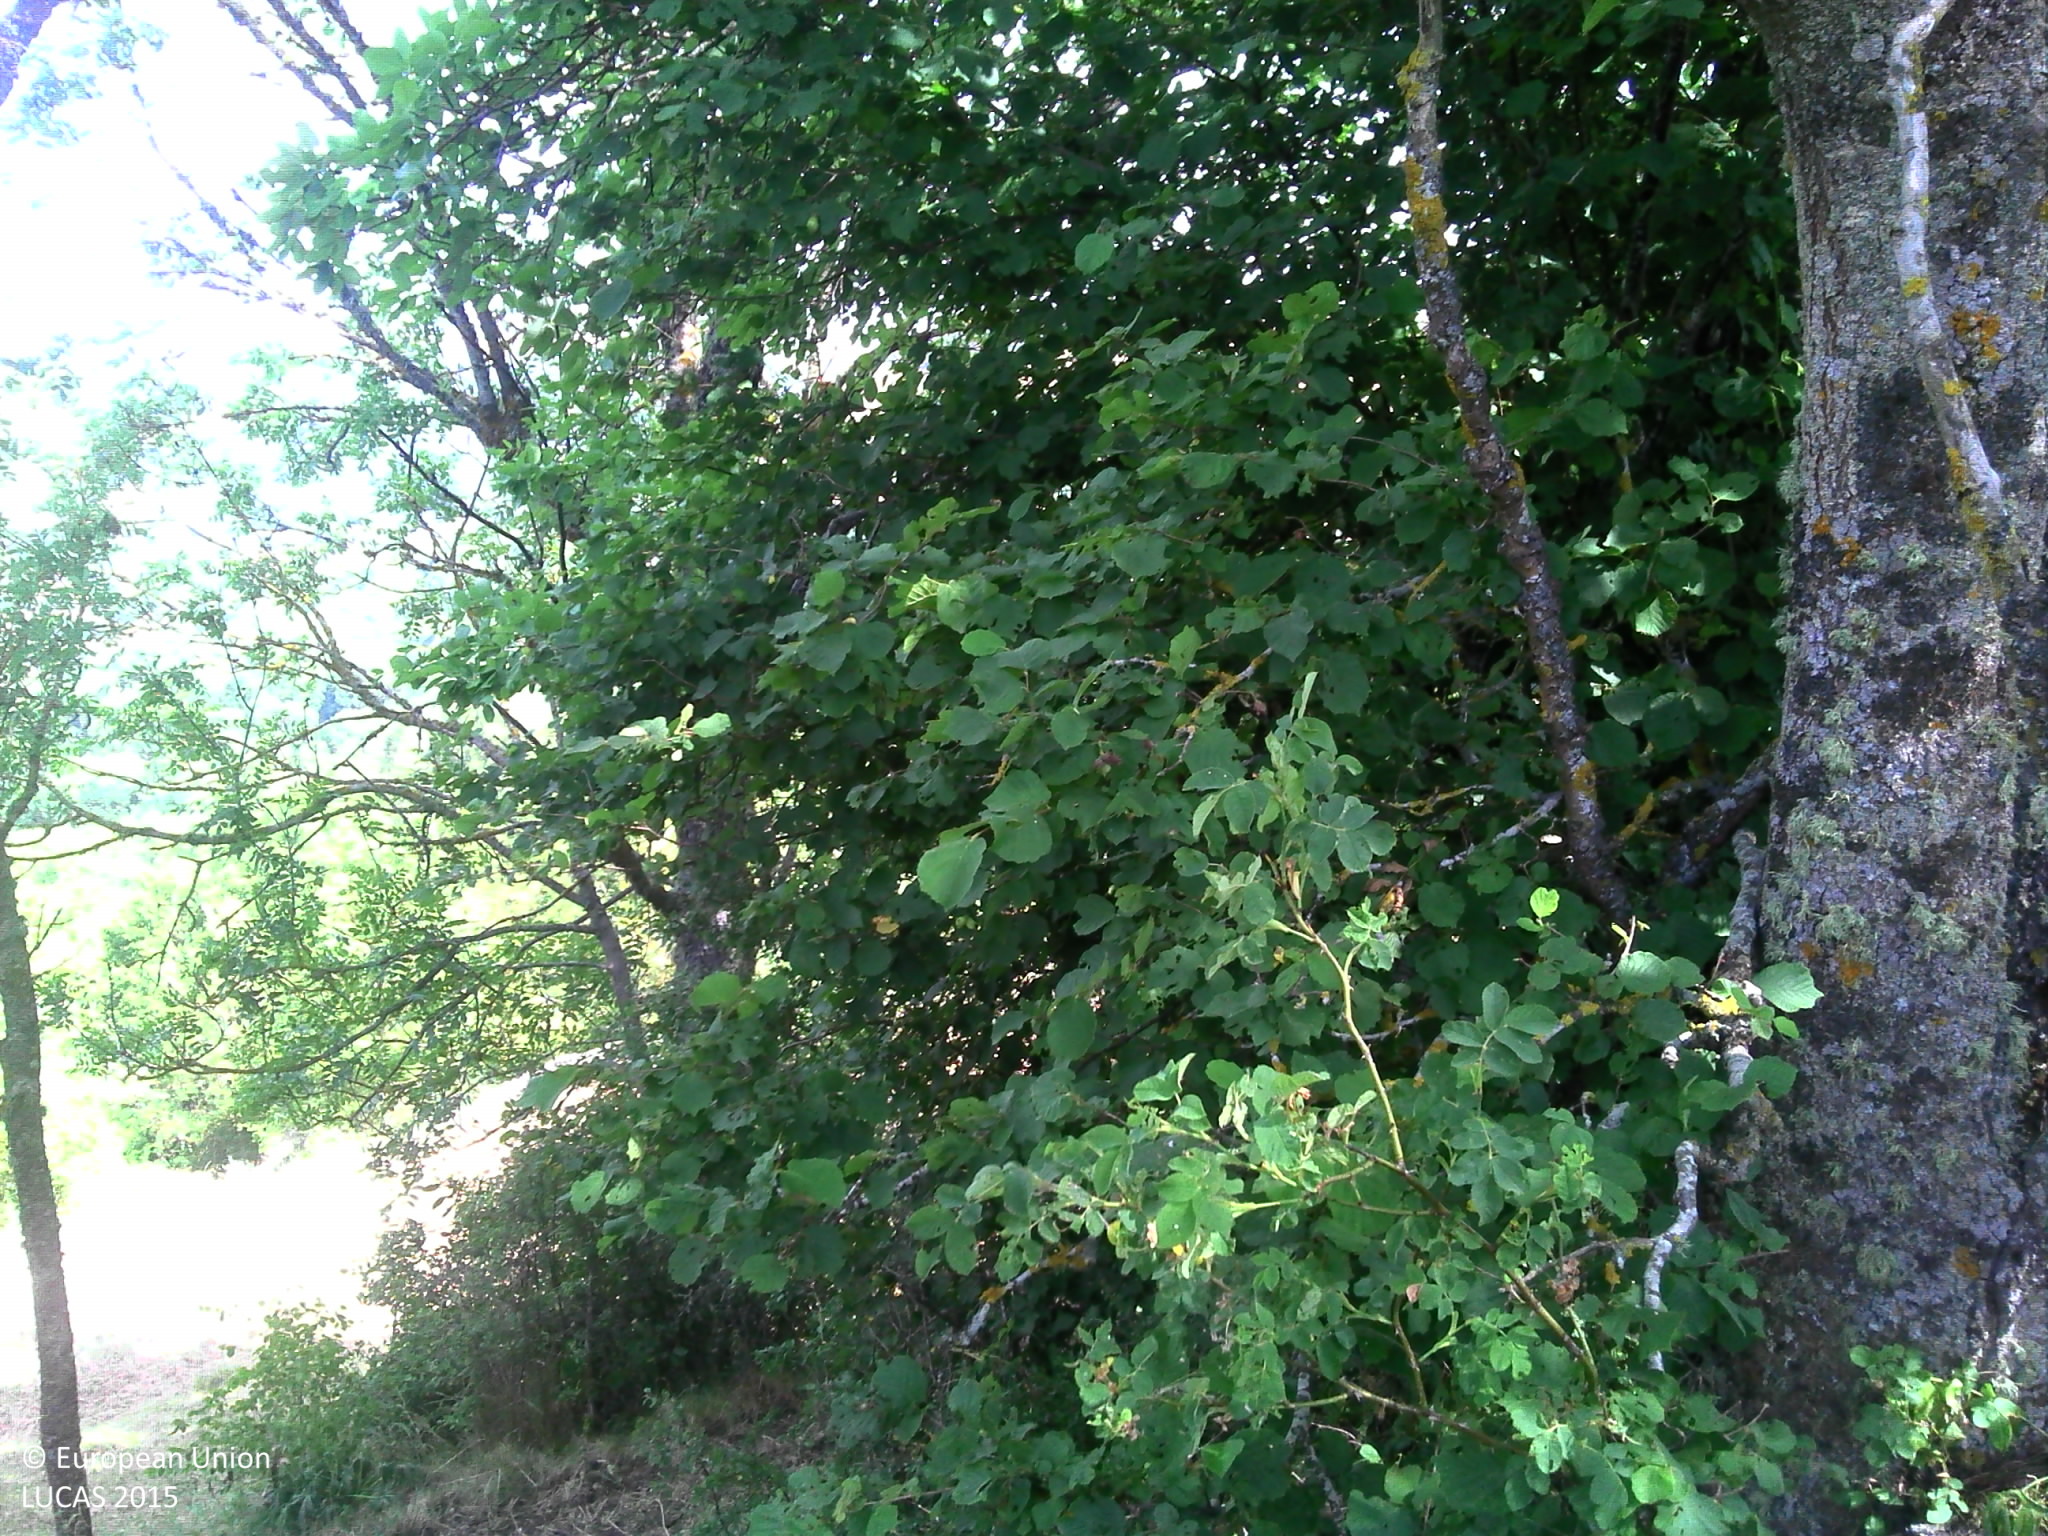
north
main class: Woodland
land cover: Broadleaved woodland
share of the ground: > 75 %
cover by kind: broadleaved forest trees 60 %, herbaceous plants 30 %, shrubs 10 %
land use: Agriculture (excluding fallow land and kitchen gardens)
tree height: > 5 m
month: July
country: FR
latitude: 45.1287
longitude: 3.0215
